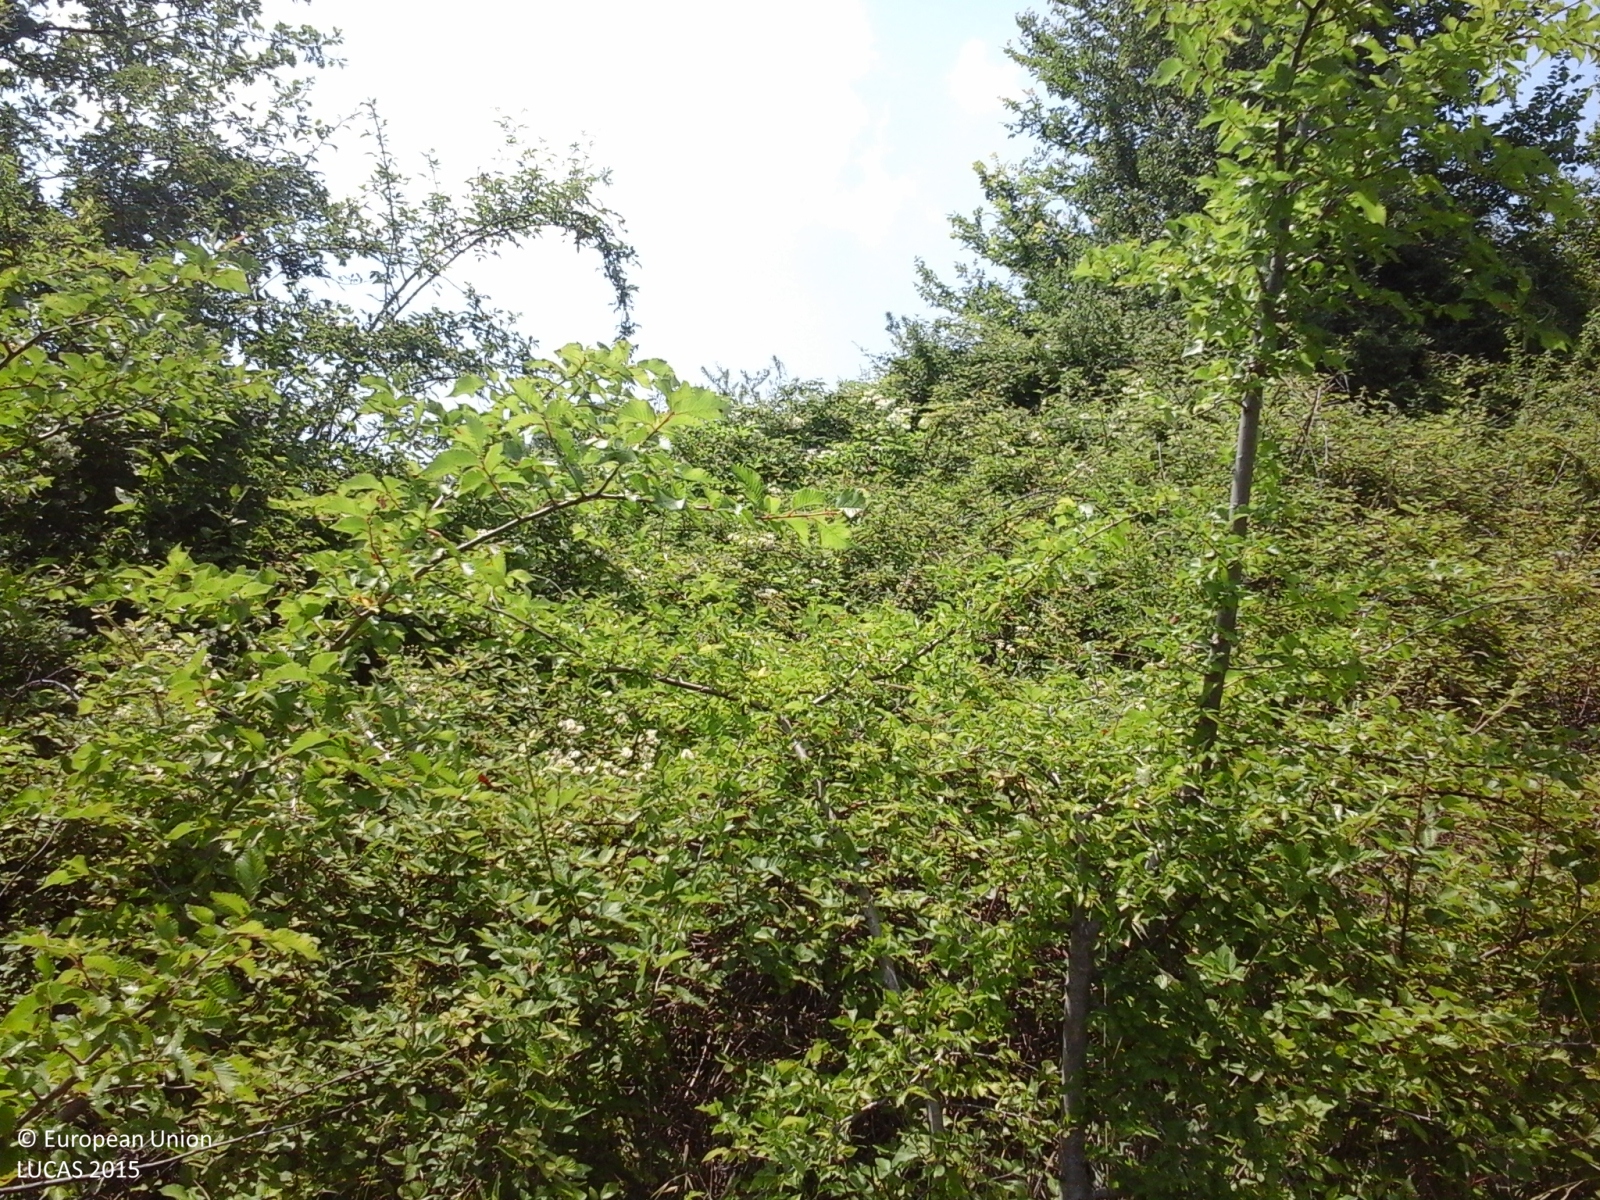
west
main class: Woodland
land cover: Broadleaved woodland
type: thermophilous deciduous forest
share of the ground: > 75 %
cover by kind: broadleaved forest trees 60 %, shrubs 30 %, herbaceous plants 10 %
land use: Semi-natural and natural areas not in use
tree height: < 5 m
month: June
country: IT
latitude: 43.1260
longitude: 13.2485
